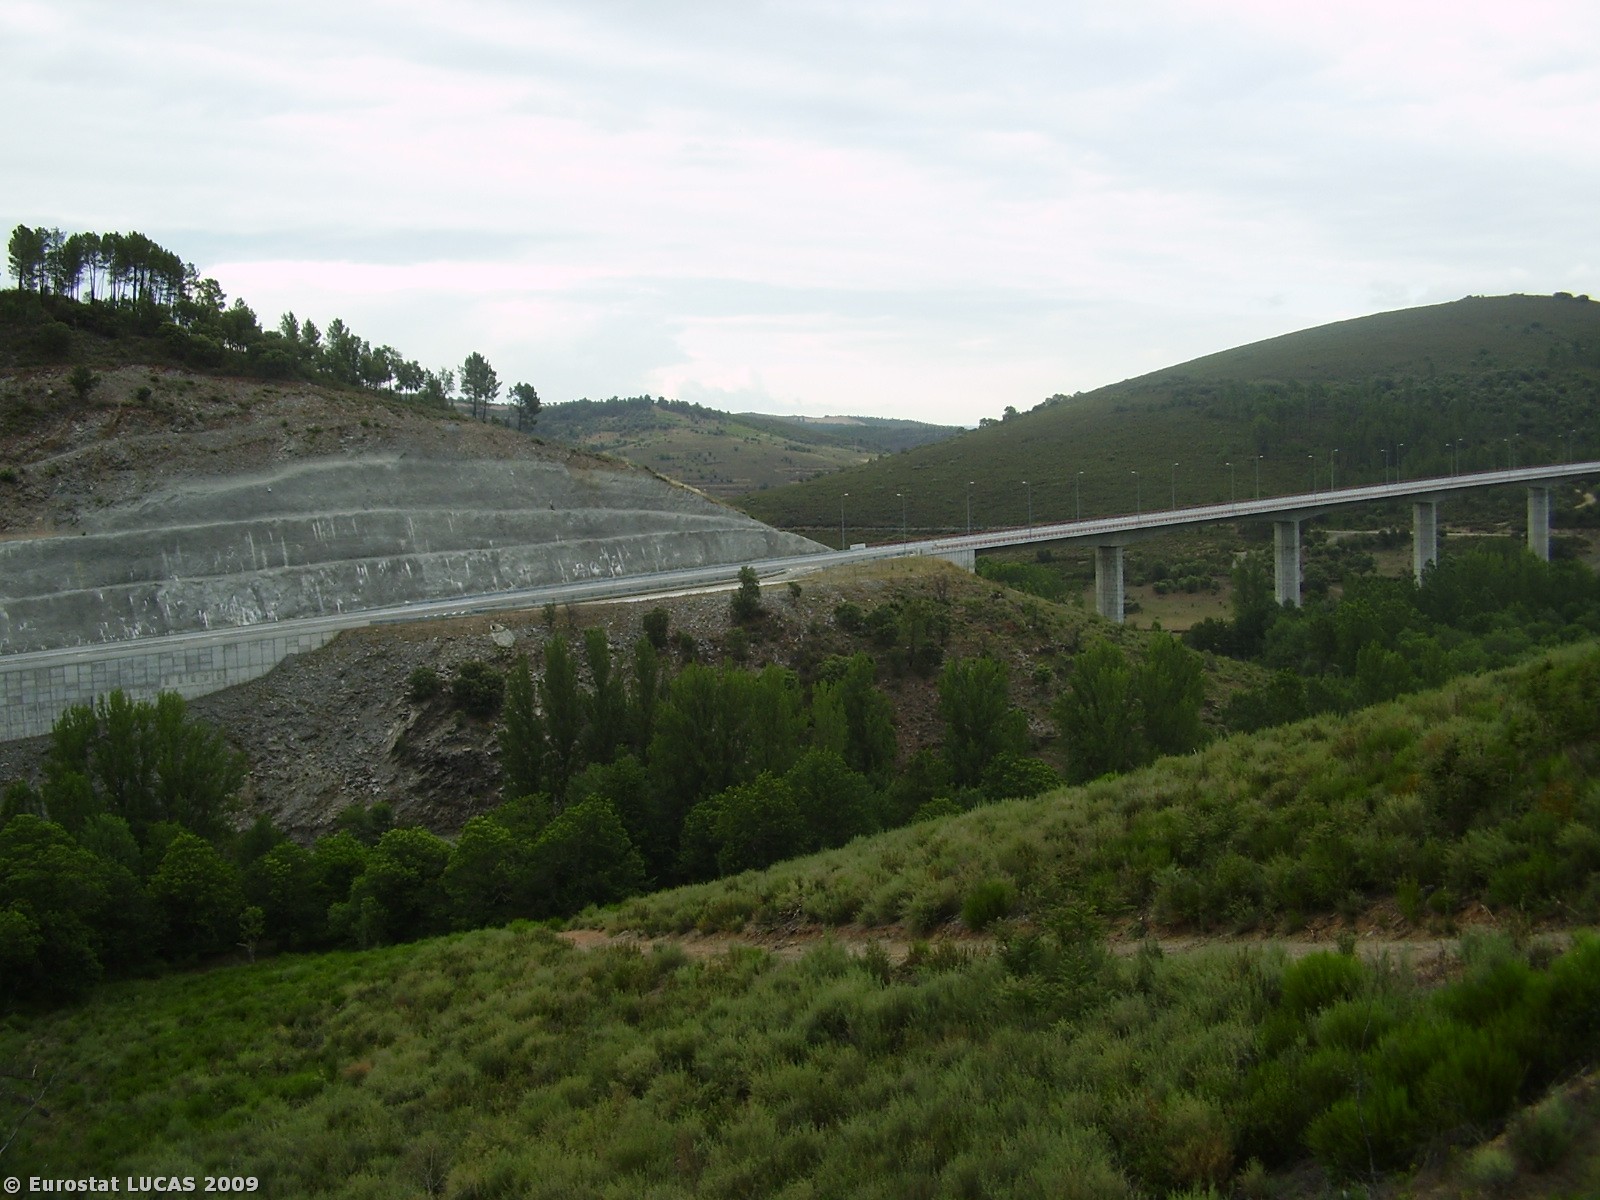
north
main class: Shrubland
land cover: Shrubland with sparse tree cover
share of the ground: > 75 %
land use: Nature reserves
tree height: > 5 m
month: June
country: PT
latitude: 41.7383
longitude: -6.5681
